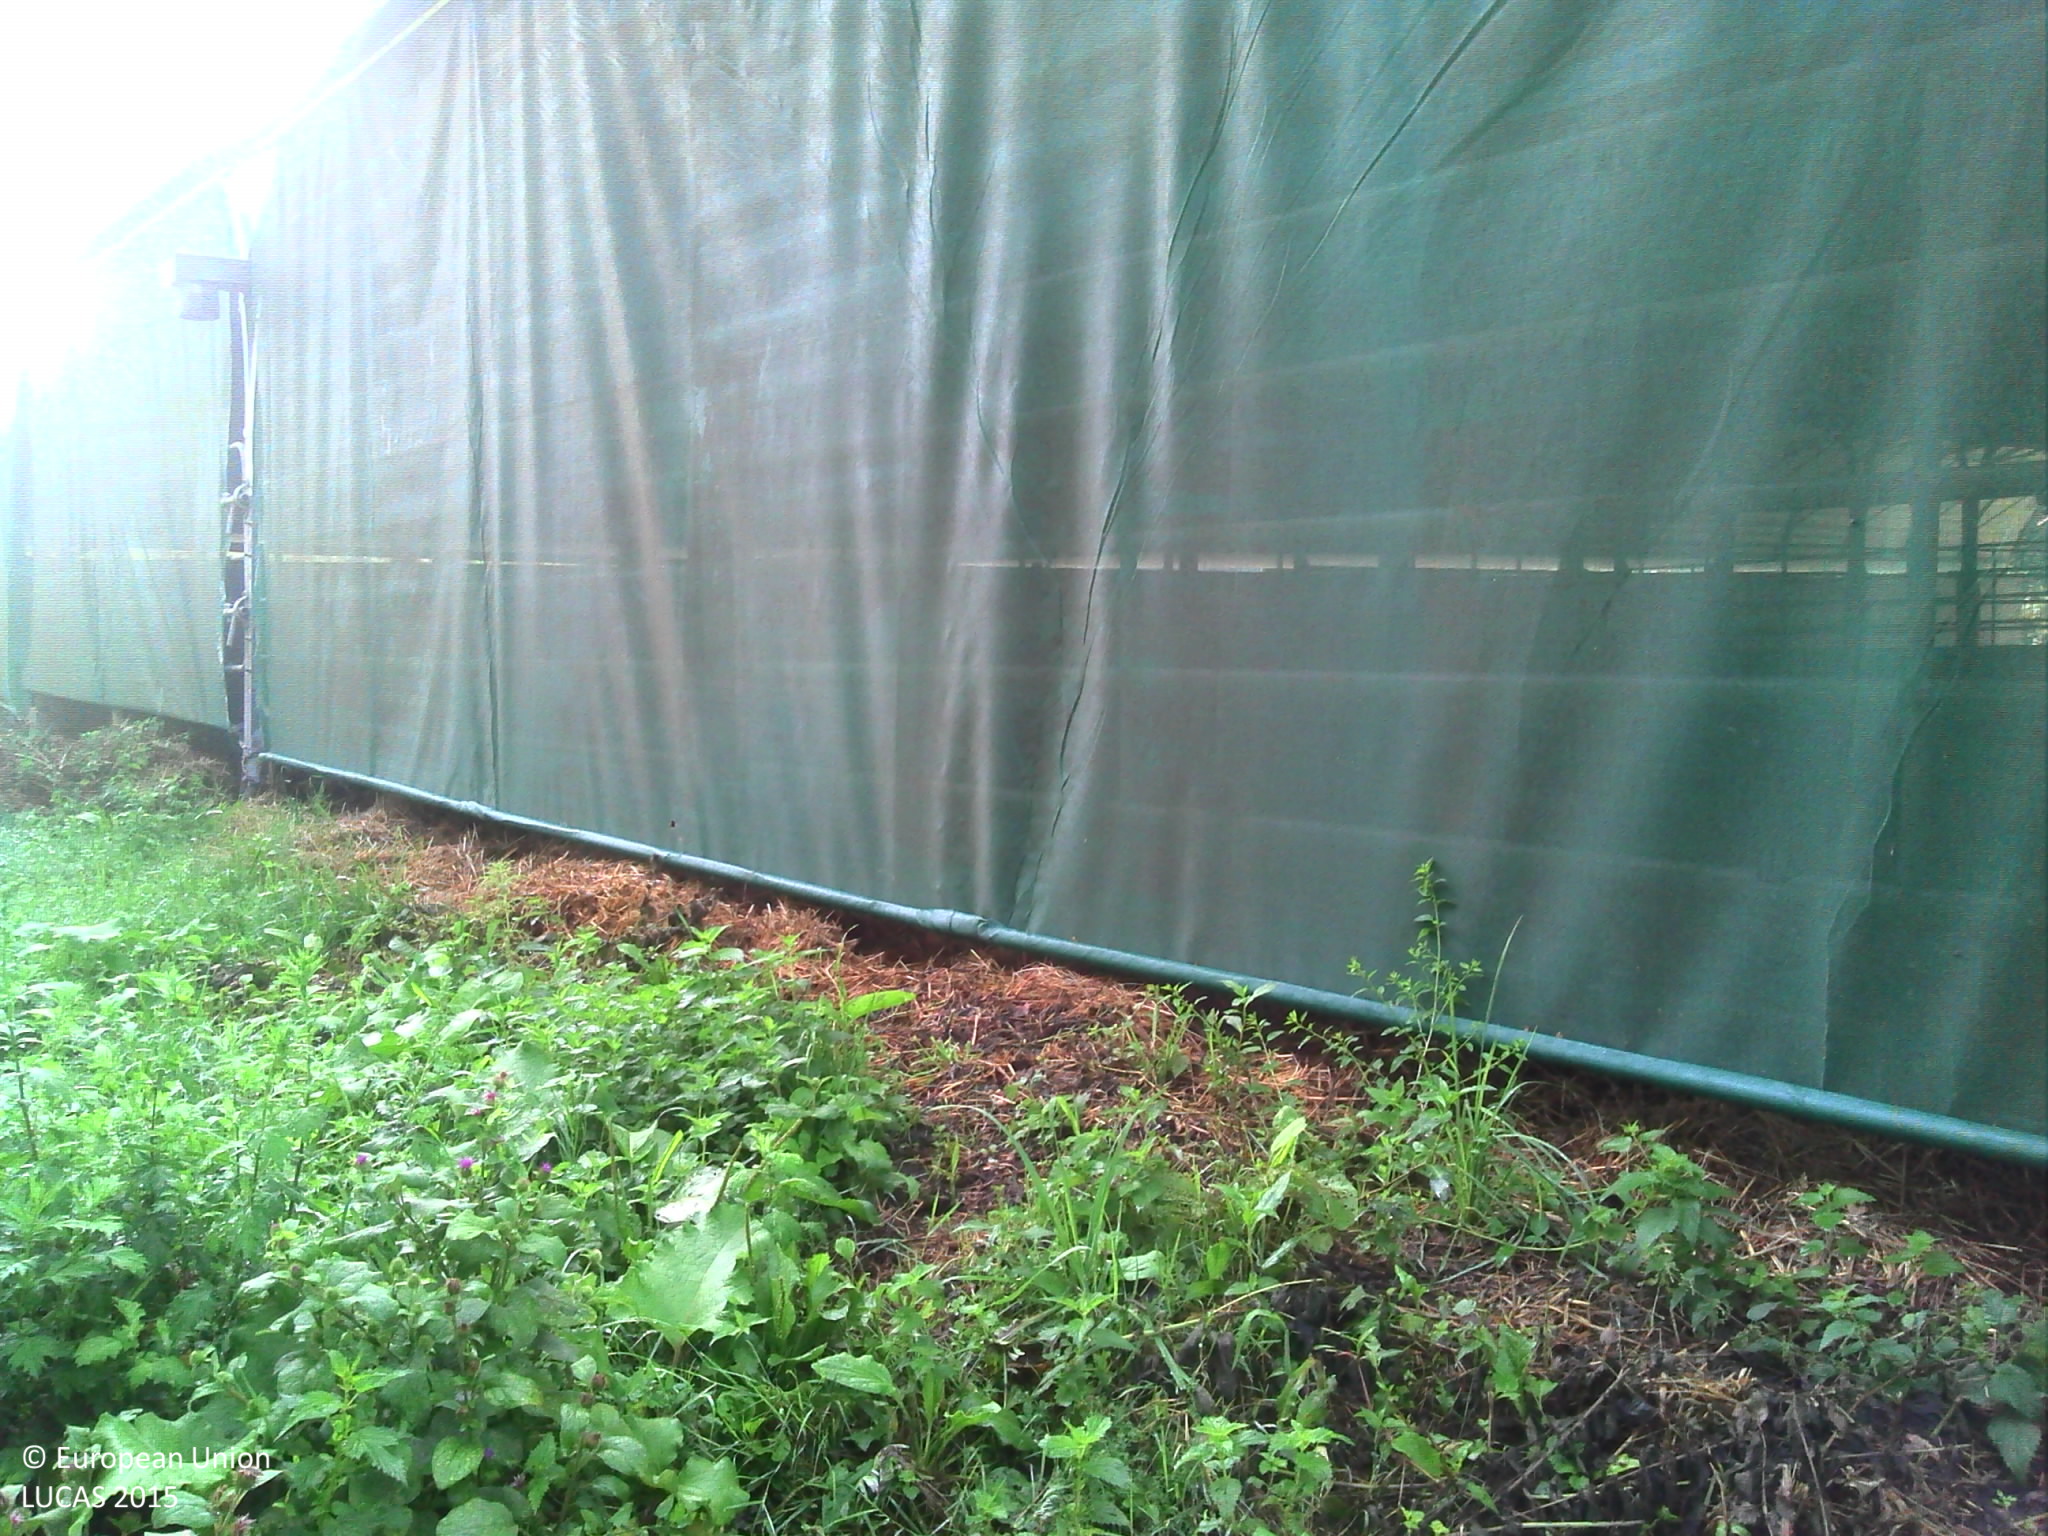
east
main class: Grassland
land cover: Grassland without tree/shrub cover
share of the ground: > 75 %
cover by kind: herbaceous plants 100 %
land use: Agriculture (excluding fallow land and kitchen gardens)
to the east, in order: Grassland without tree/shrub cover; Artificial constructions in urban areas; Shrubland without tree cover; Abandoned hedges; Shruby margins; Tracks; Grass margins; Abandoned hedges; Fences; Spontaneously vegetated surfaces; Broadleaved woodland; Grassland without tree/shrub cover; Broadleaved woodland
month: August
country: FR
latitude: 46.1893
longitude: 1.0087
